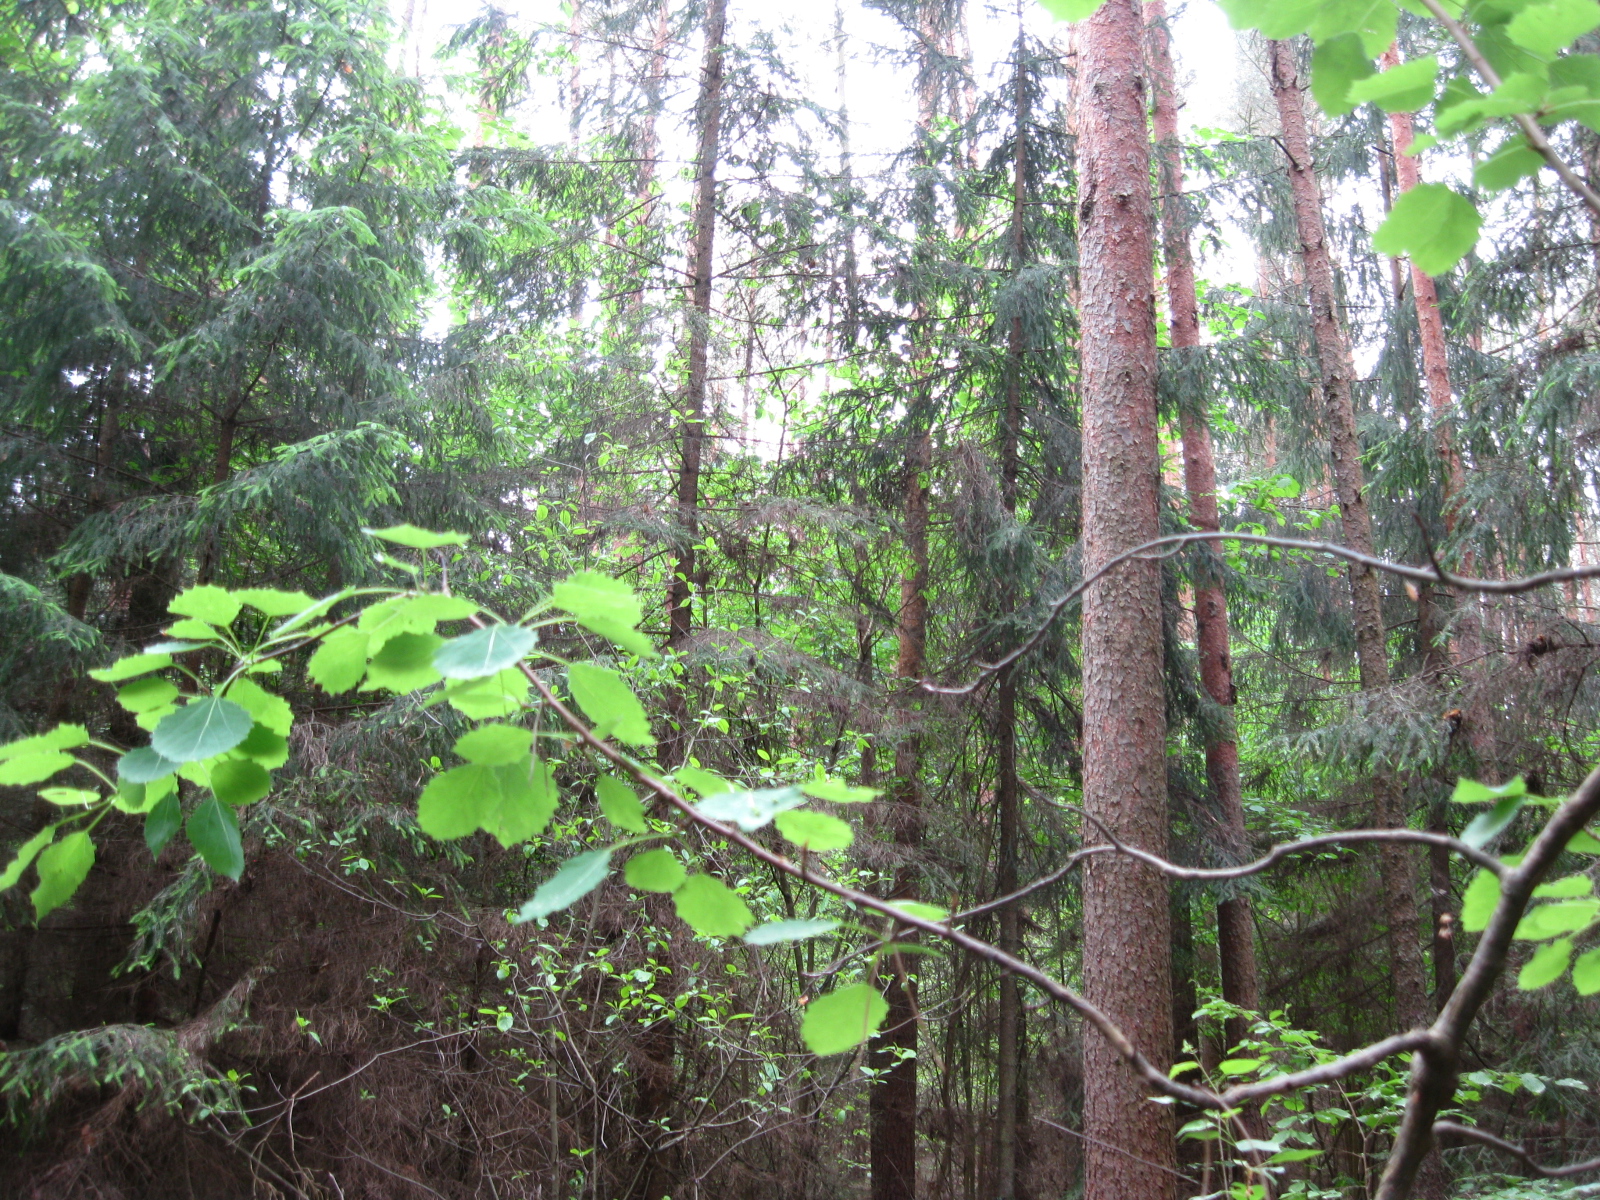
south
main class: Woodland
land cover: Other coniferous woodland
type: hemiboreal forest and nemoral coniferous forest and mixed broadleaved-coniferous forest
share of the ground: > 75 %
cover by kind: coniferous forest trees 70 %, broadleaved forest trees 10 %, lichens and mosses 10 %, shrubs 5 %, herbaceous plants 5 %
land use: Forestry
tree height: > 5 m
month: June
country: LT
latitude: 55.9801
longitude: 24.1784
